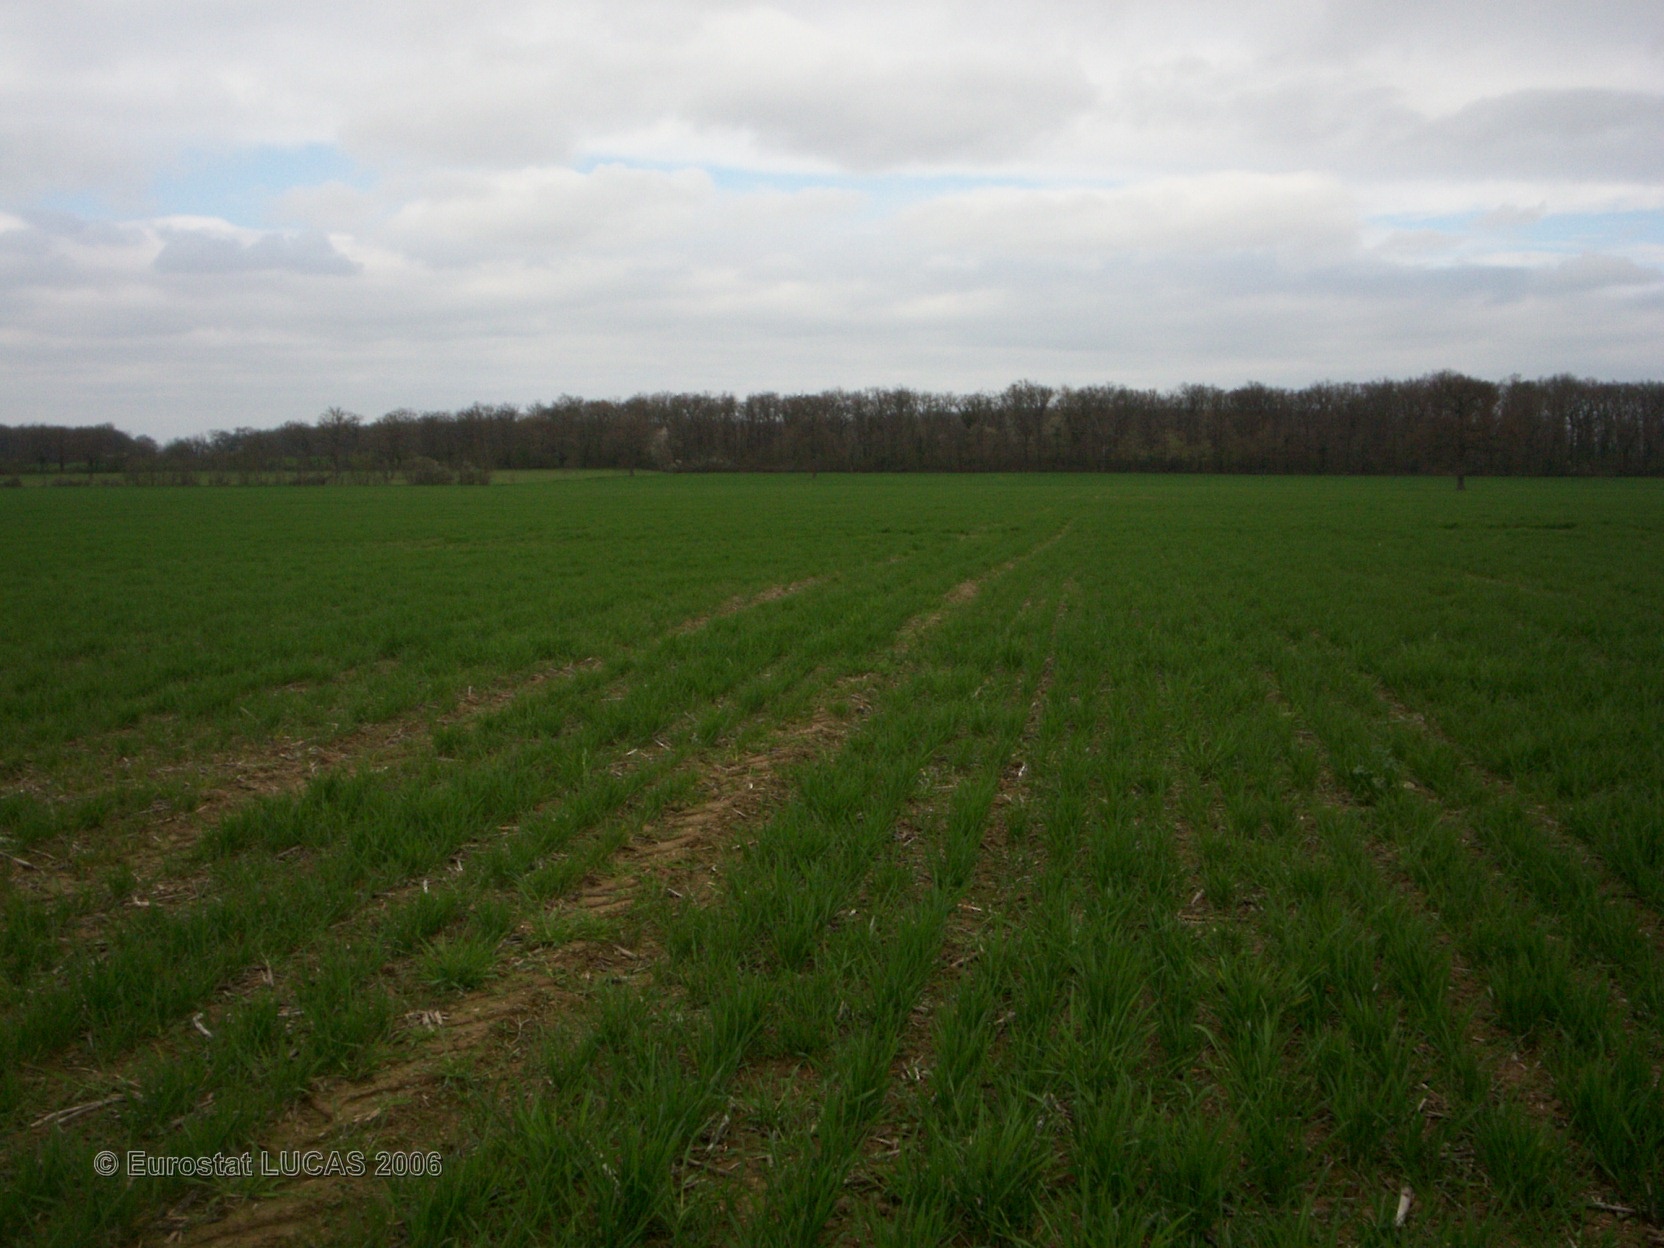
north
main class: Cropland
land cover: Common wheat
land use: Agriculture (excluding fallow land and kitchen gardens)
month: April
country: FR
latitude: 46.7214
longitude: 3.0494
